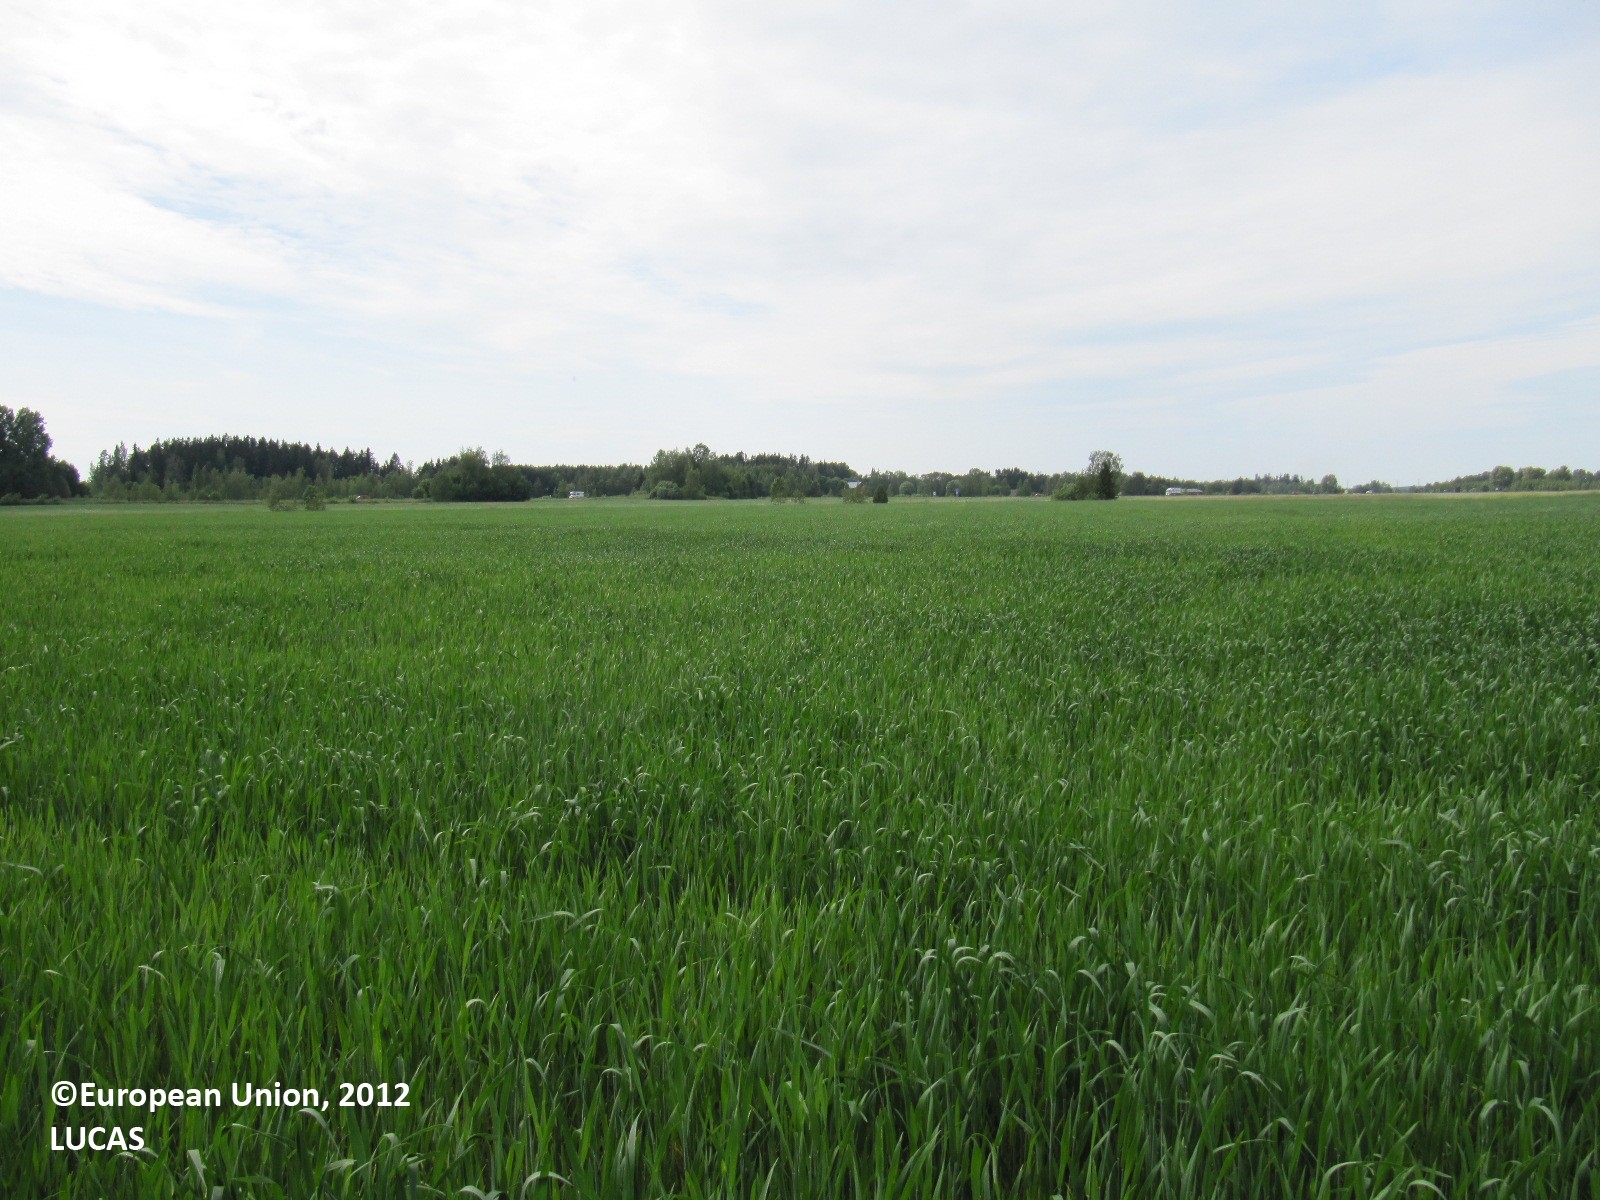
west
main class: Cropland
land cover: Common wheat
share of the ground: > 75 %
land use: Agriculture (excluding fallow land and kitchen gardens)
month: July
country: FI
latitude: 60.9511
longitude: 23.3555
